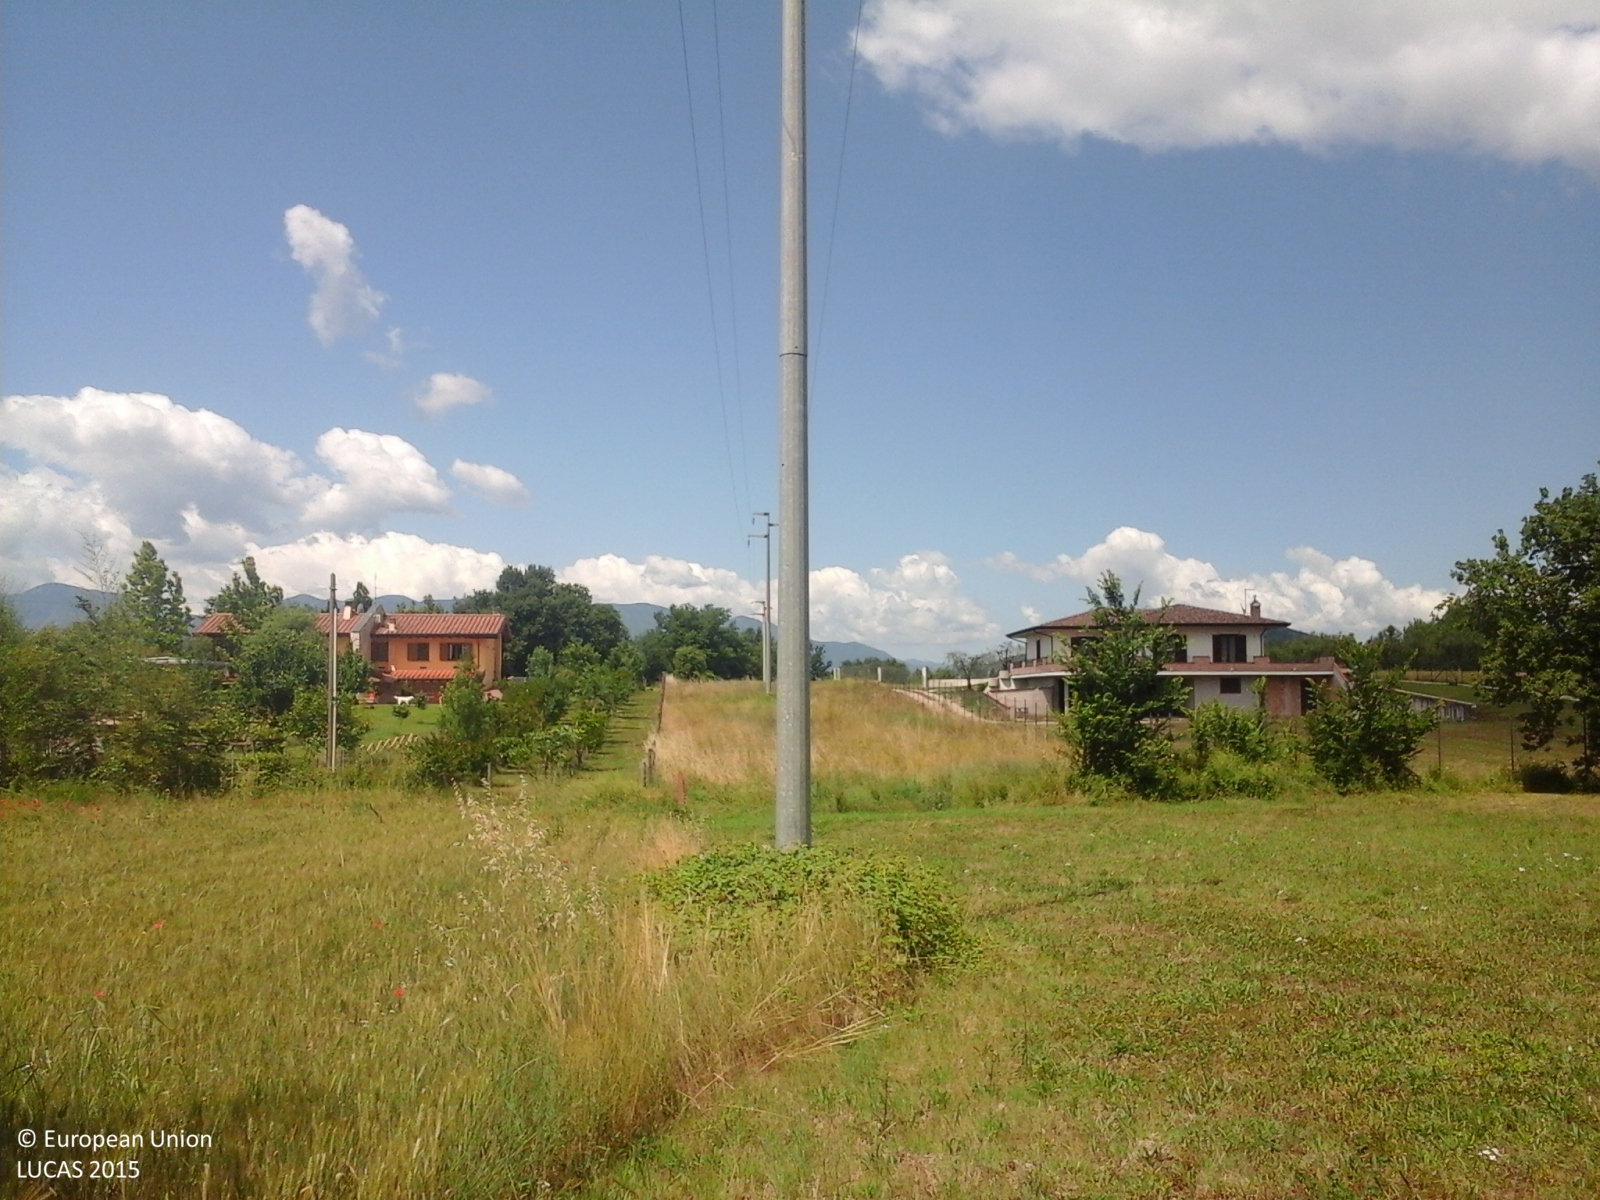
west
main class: Cropland
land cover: Durum wheat
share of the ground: > 75 %
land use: Agriculture (excluding fallow land and kitchen gardens)
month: May
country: IT
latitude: 41.6760
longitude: 13.3628
